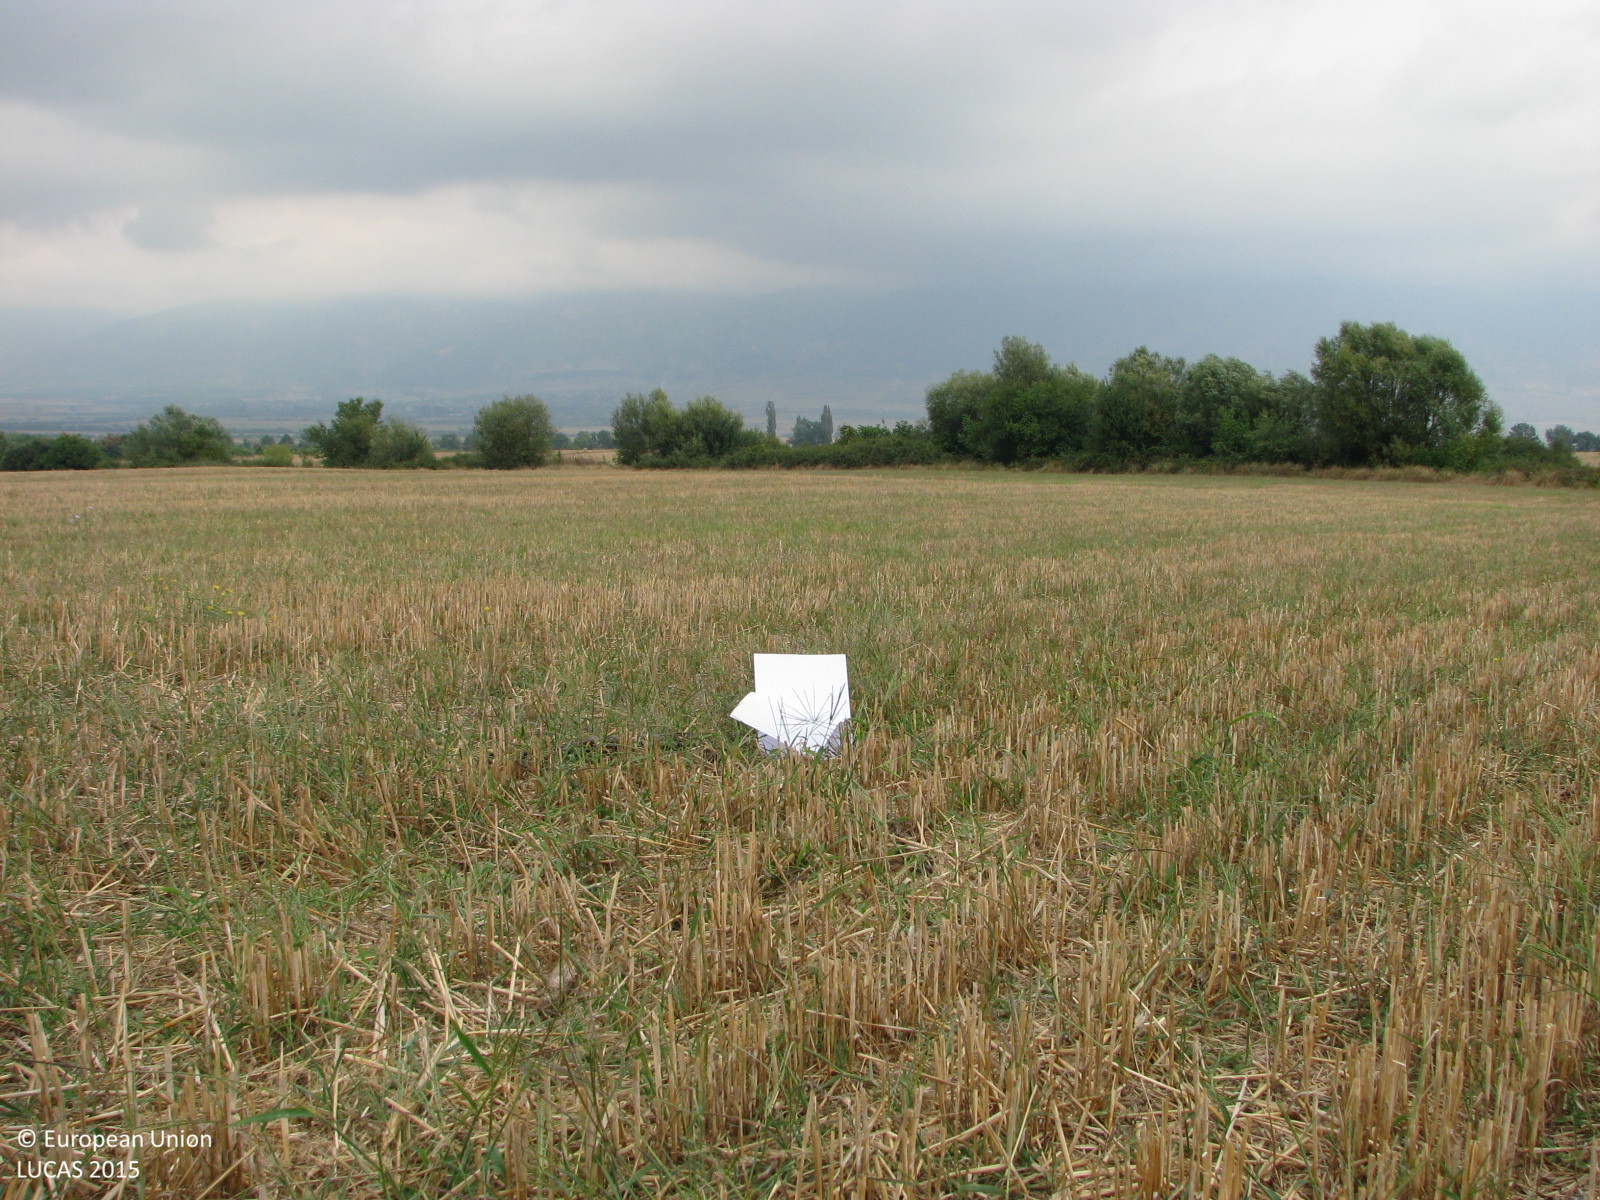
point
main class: Cropland
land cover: Common wheat
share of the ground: 25 - 50 %
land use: Agriculture (excluding fallow land and kitchen gardens)
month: August
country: BG
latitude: 42.6405
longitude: 25.9981
